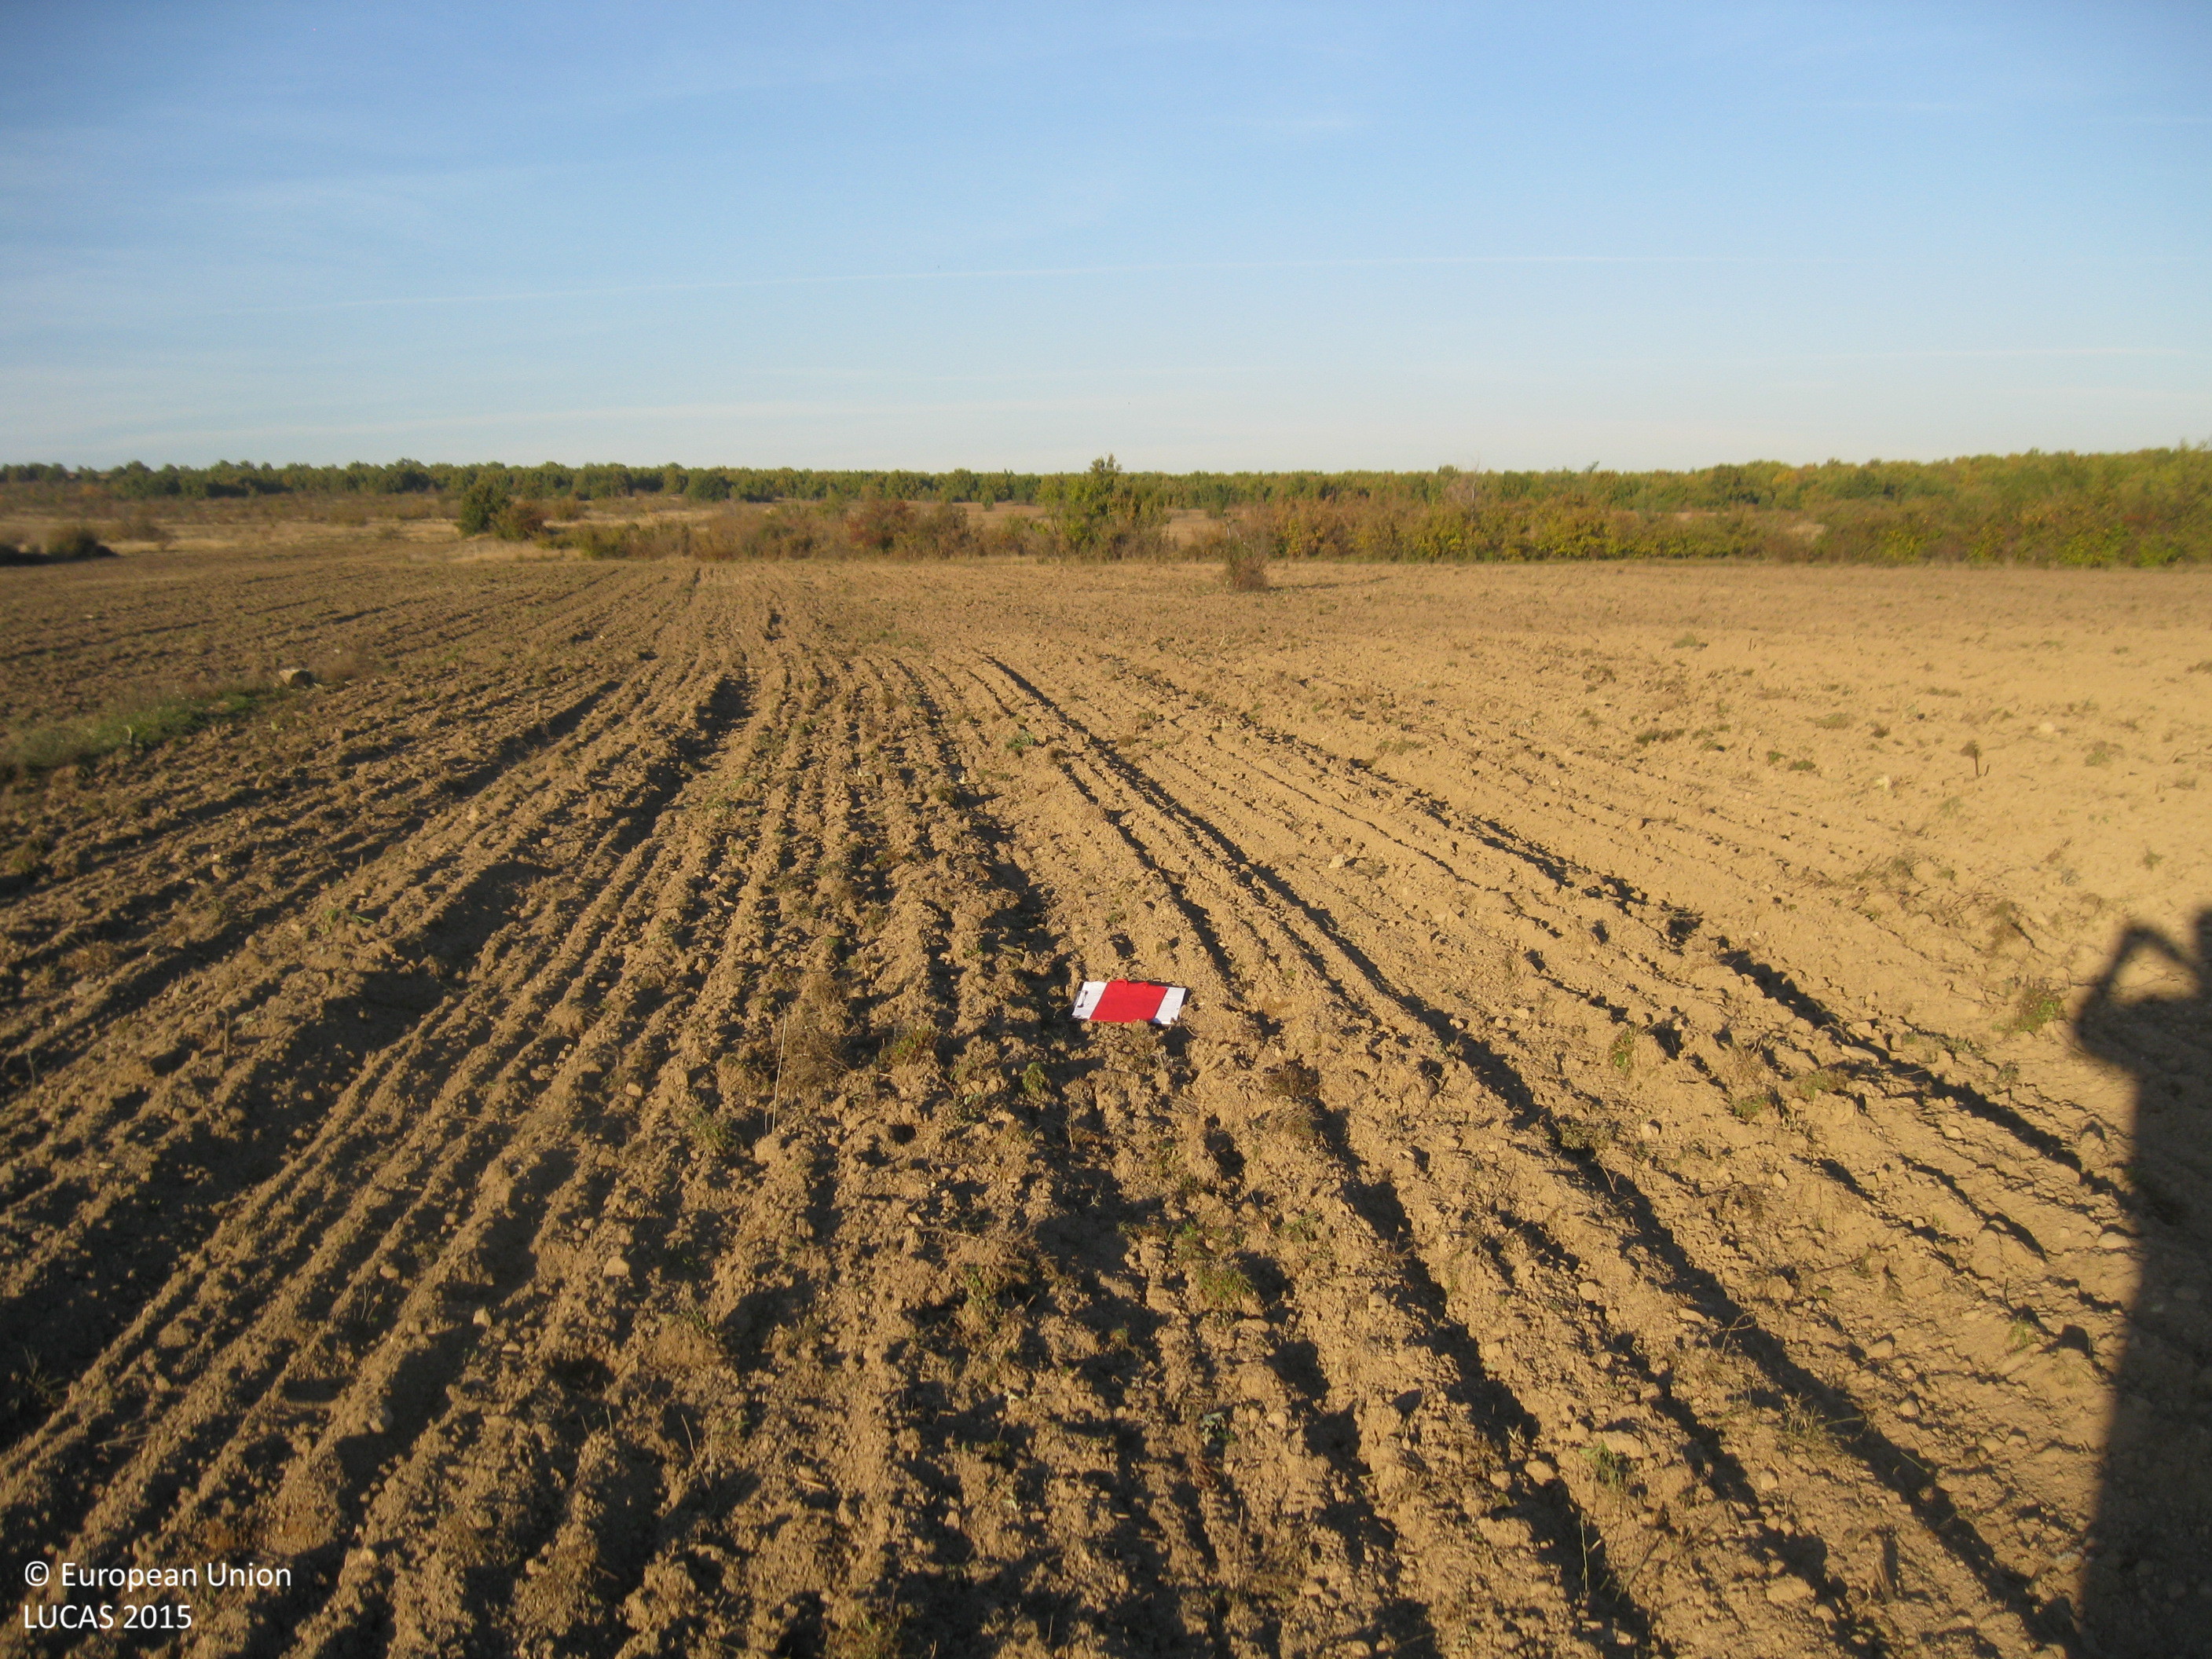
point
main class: Cropland
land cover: Sunflower
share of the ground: < 10 %
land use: Agriculture (excluding fallow land and kitchen gardens)
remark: Harvested field
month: November
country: BG
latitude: 42.3210
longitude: 24.2291
